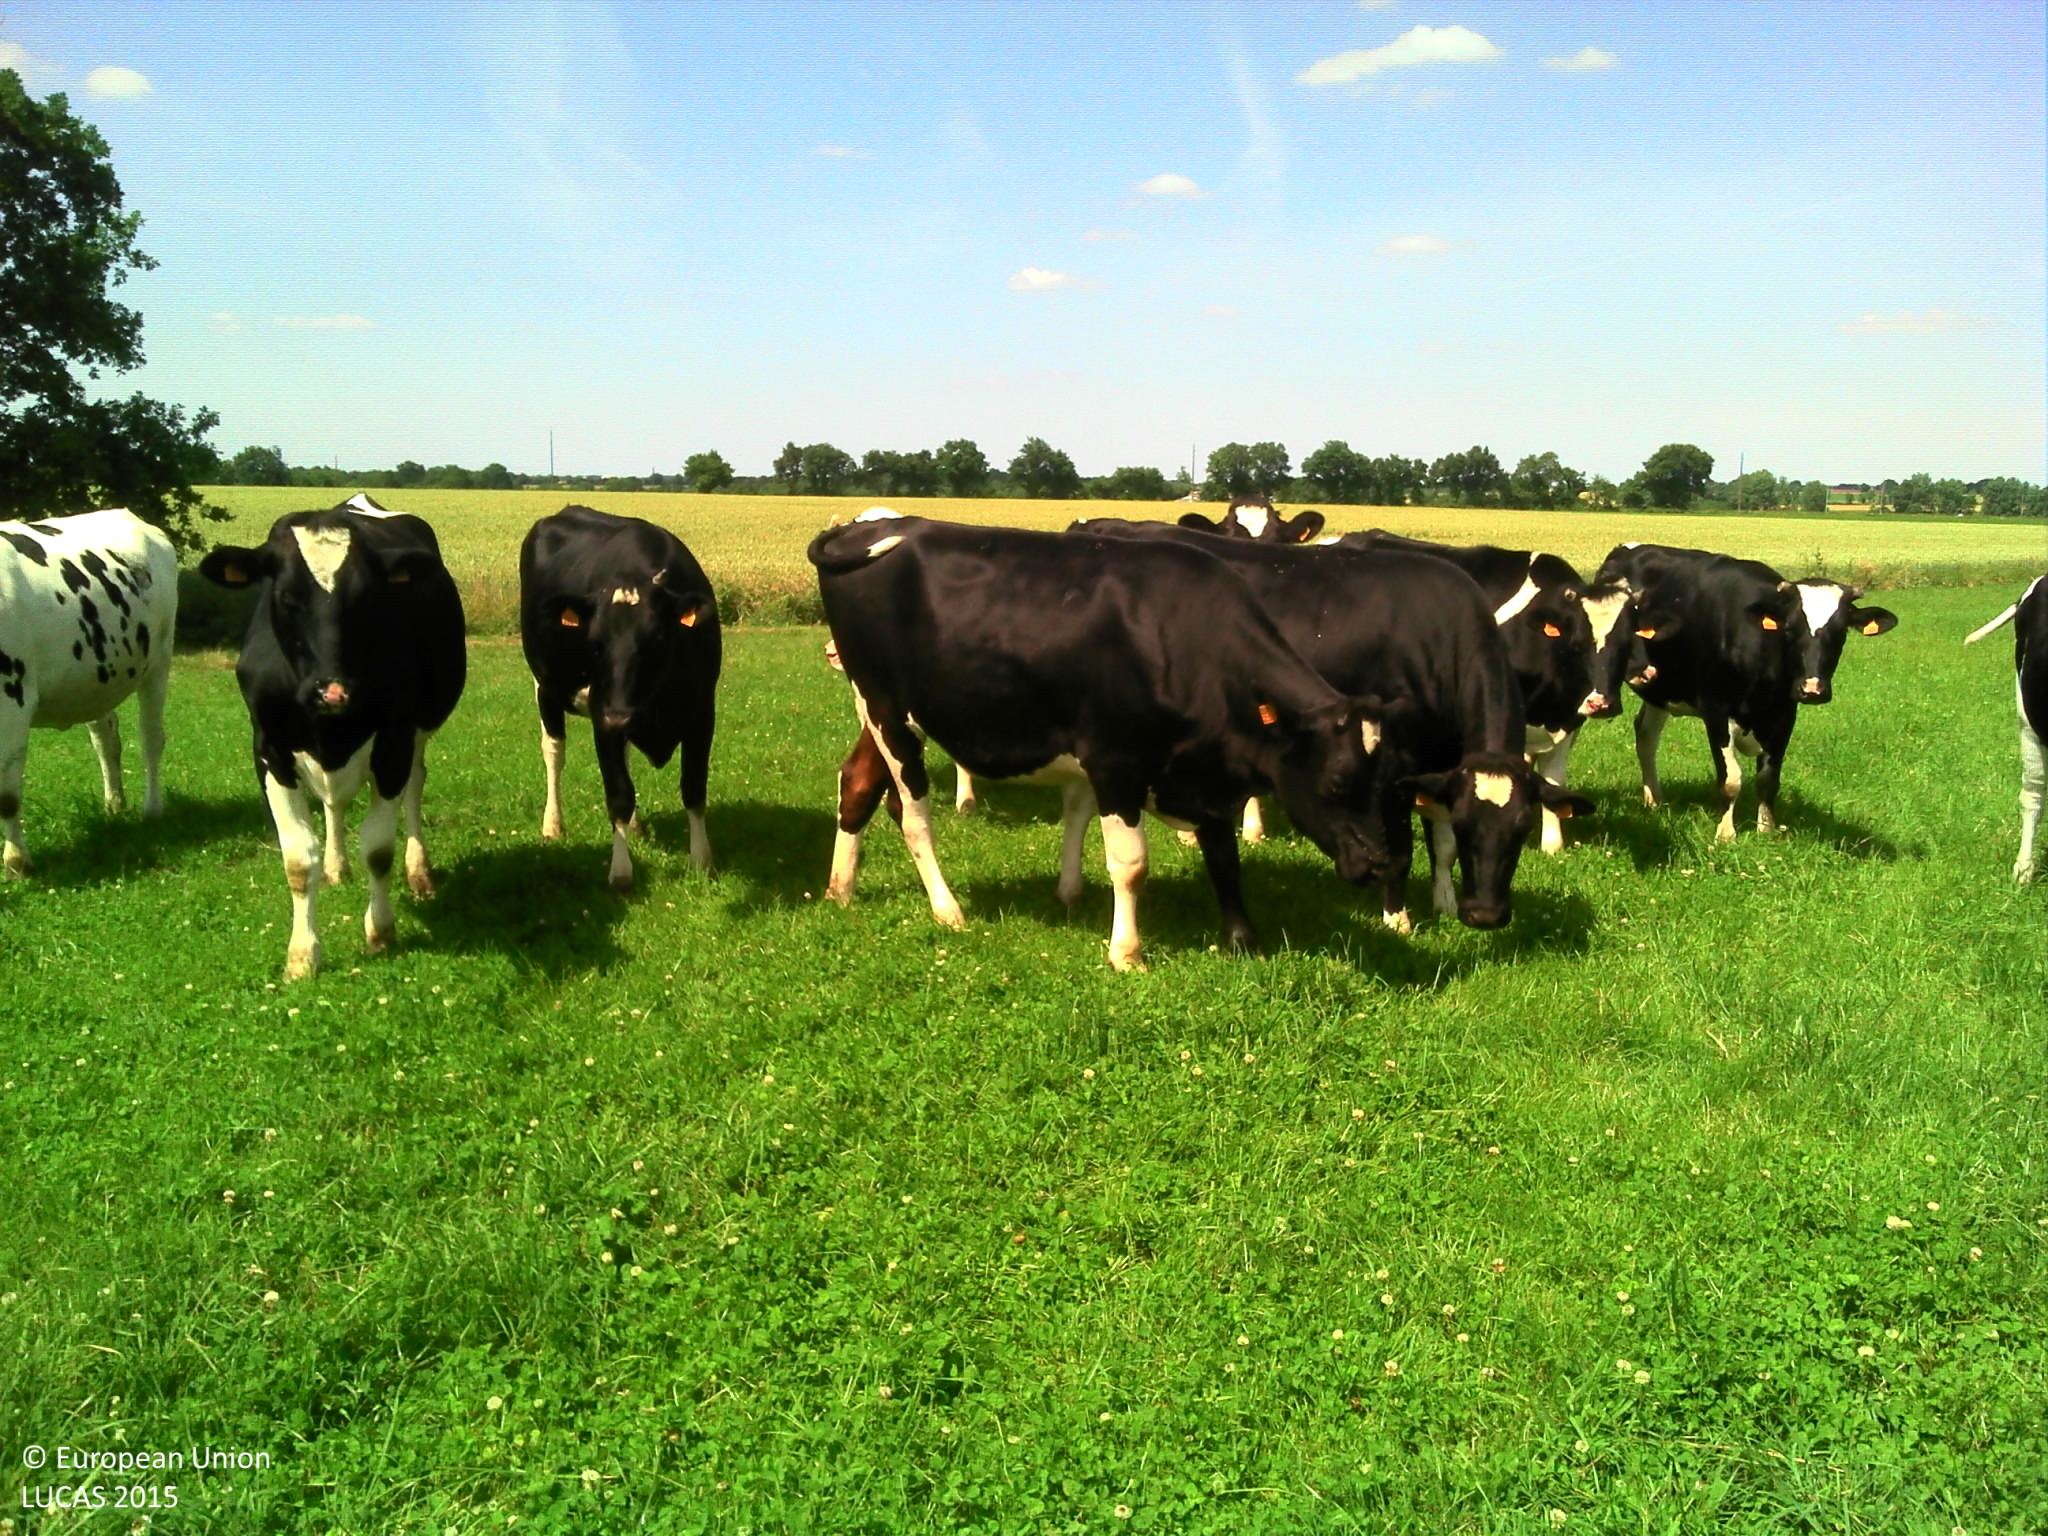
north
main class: Cropland
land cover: Temporary grasslands
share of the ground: > 75 %
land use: Agriculture (excluding fallow land and kitchen gardens)
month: June
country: FR
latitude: 46.8627
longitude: -1.4381
